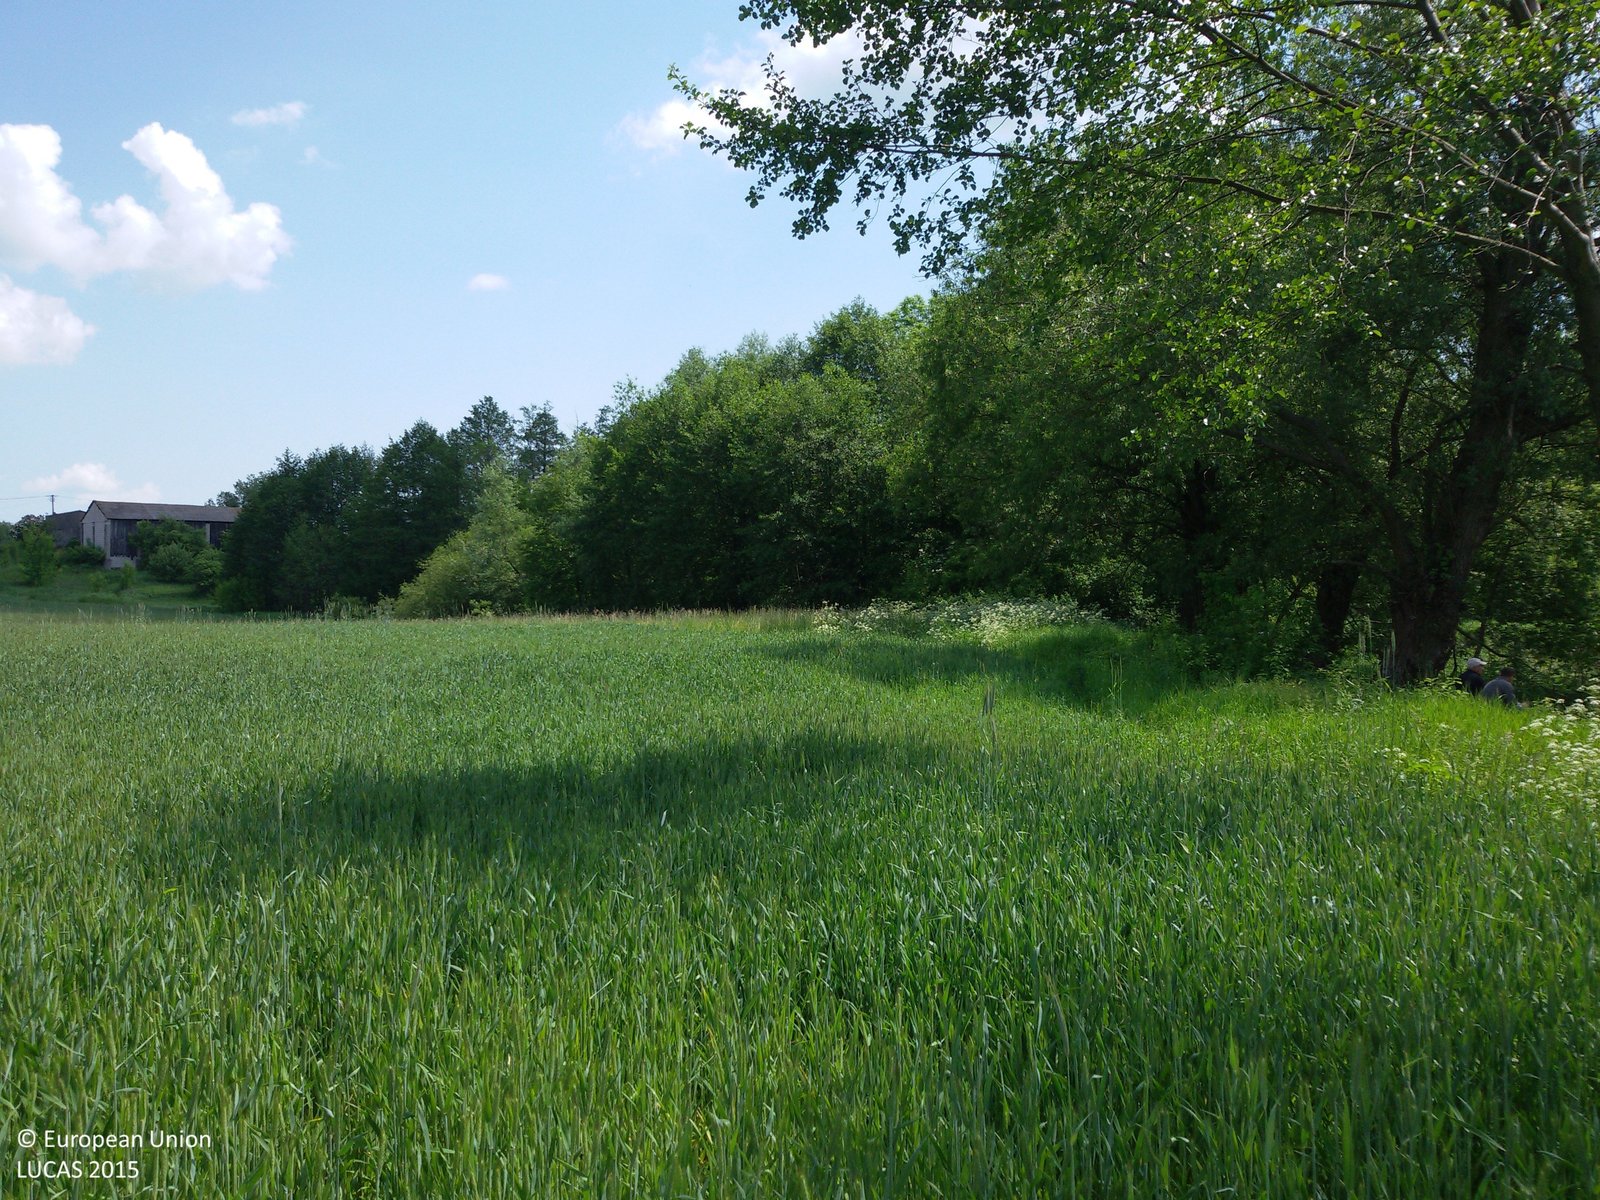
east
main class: Cropland
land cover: Rye
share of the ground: > 75 %
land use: Agriculture (excluding fallow land and kitchen gardens)
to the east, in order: Rye; Grassland without tree/shrub cover; Broadleaved woodland; Spontaneously vegetated surfaces; Artificial constructions in urban areas; Grass margins
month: May
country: PL
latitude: 51.3584
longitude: 22.7514
